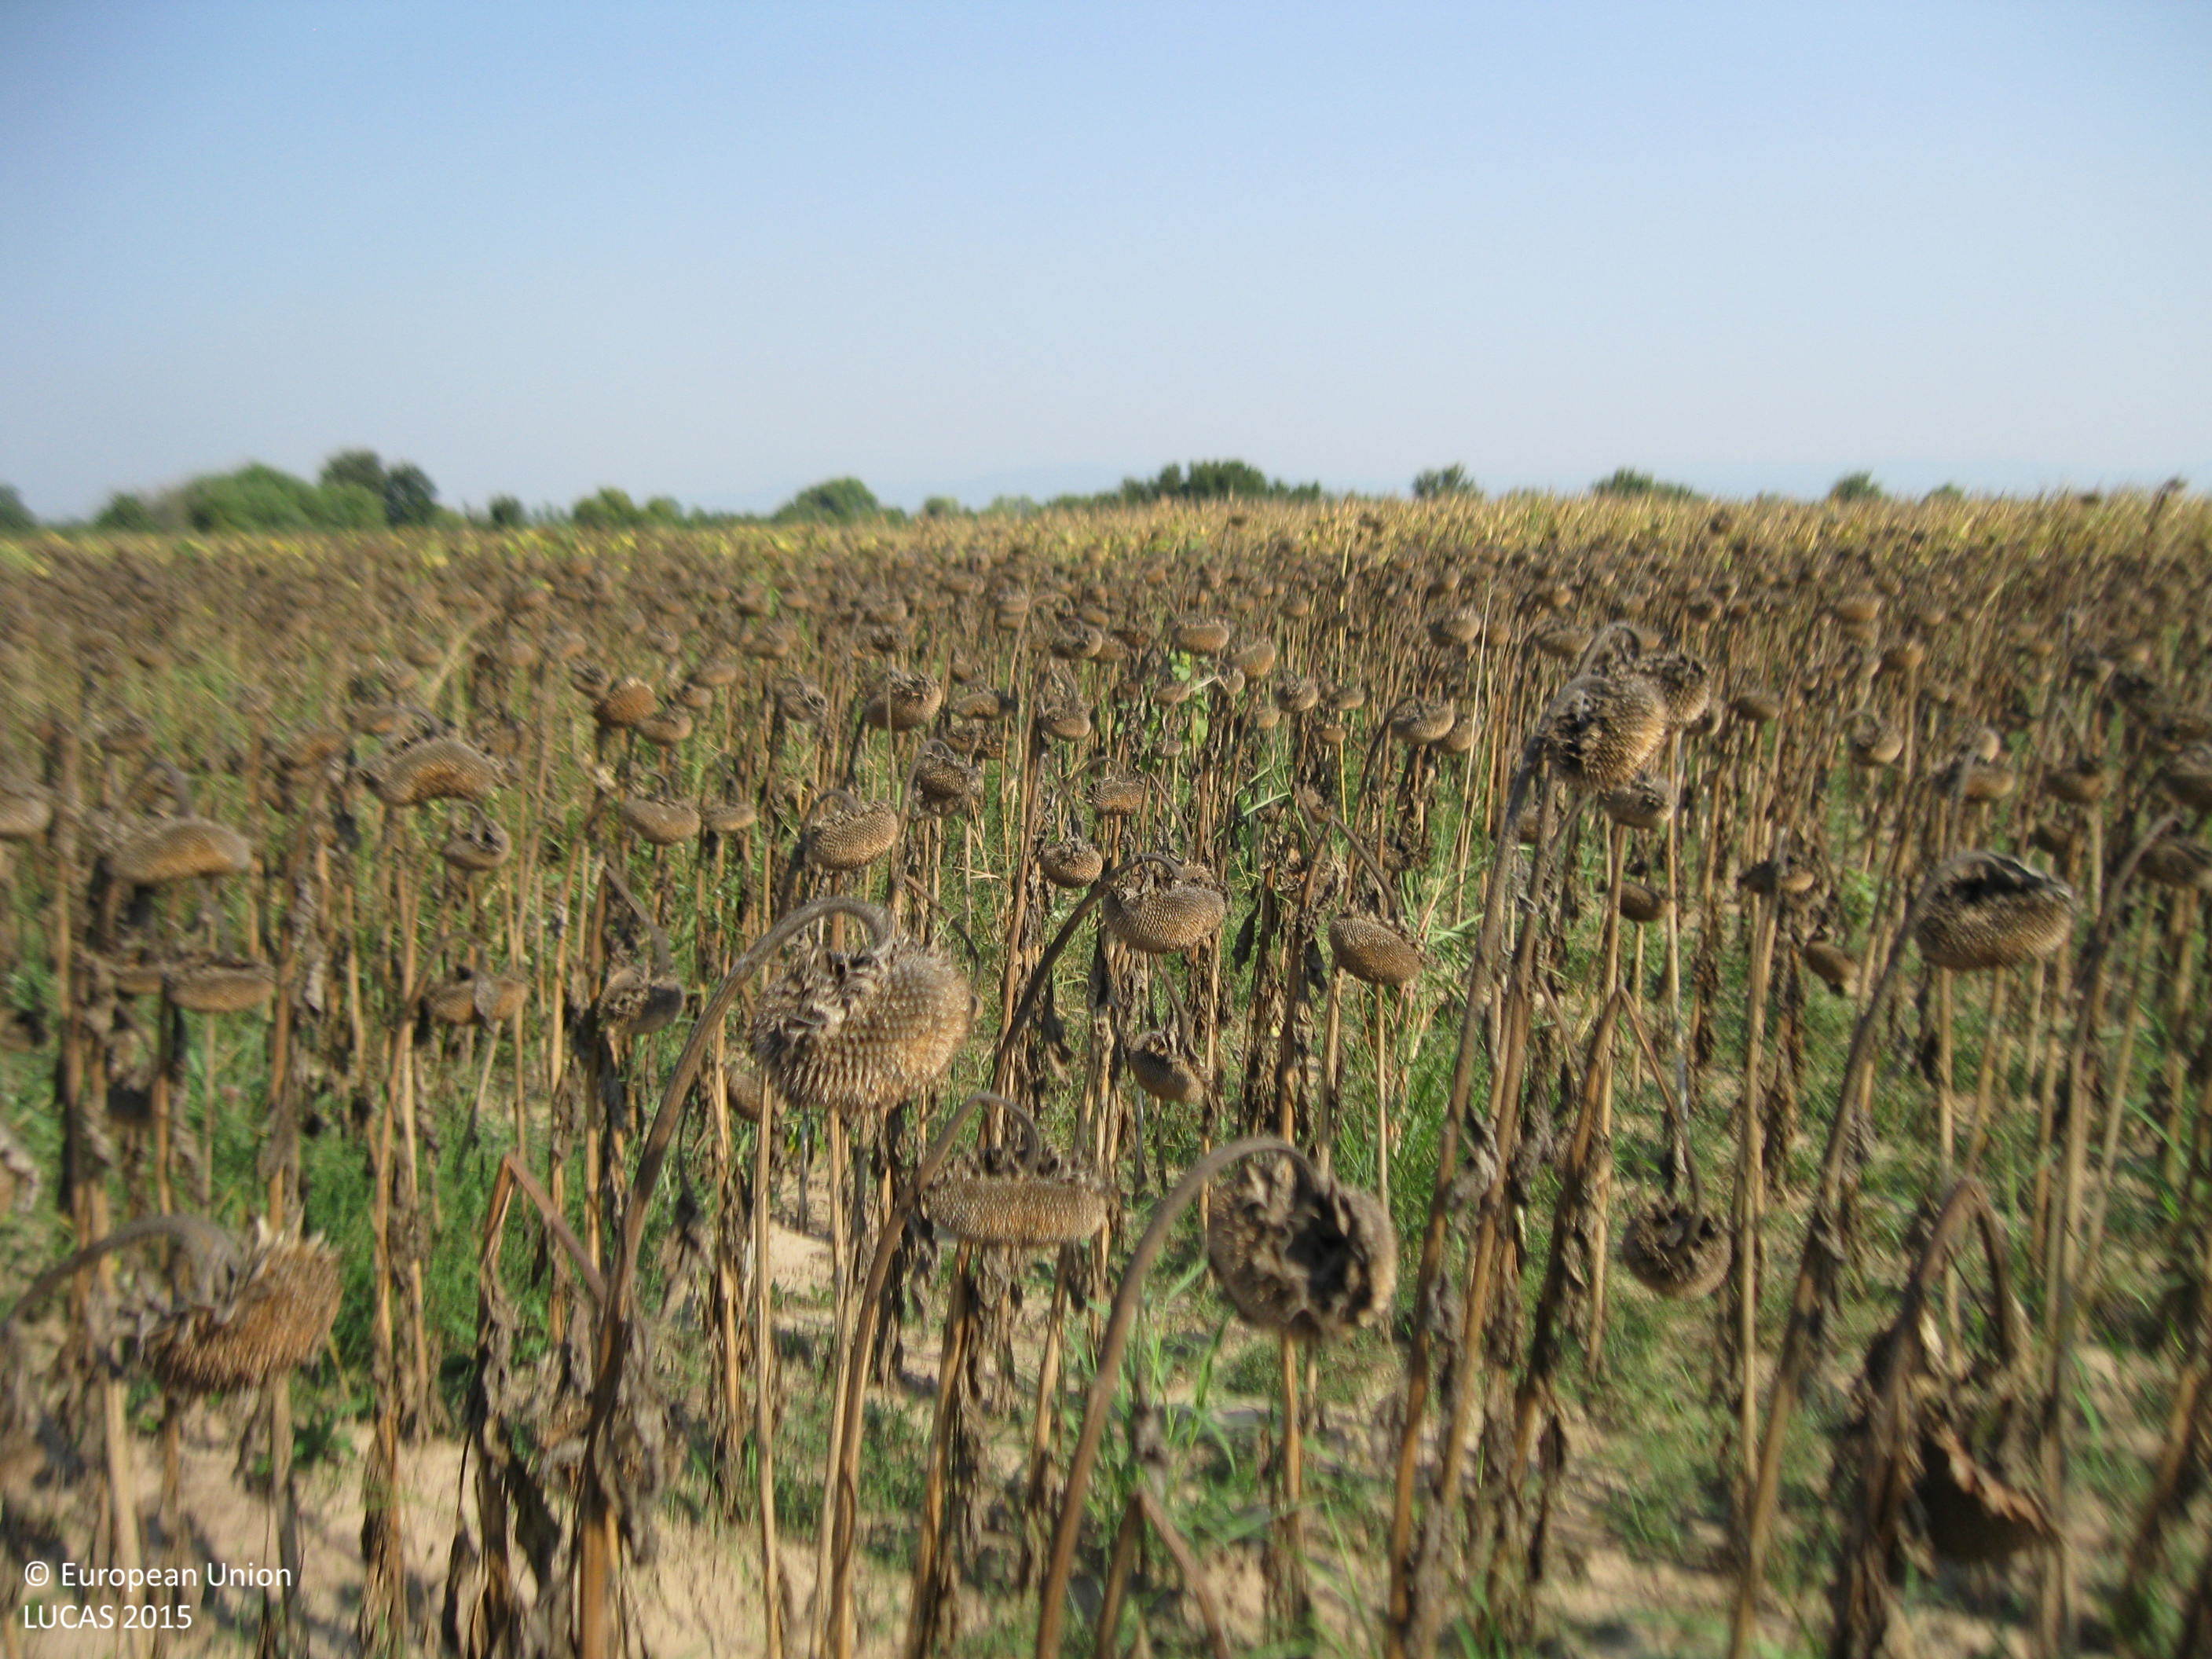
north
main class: Cropland
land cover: Sunflower
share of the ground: > 75 %
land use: Agriculture (excluding fallow land and kitchen gardens)
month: September
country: BG
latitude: 42.2624
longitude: 25.0049
